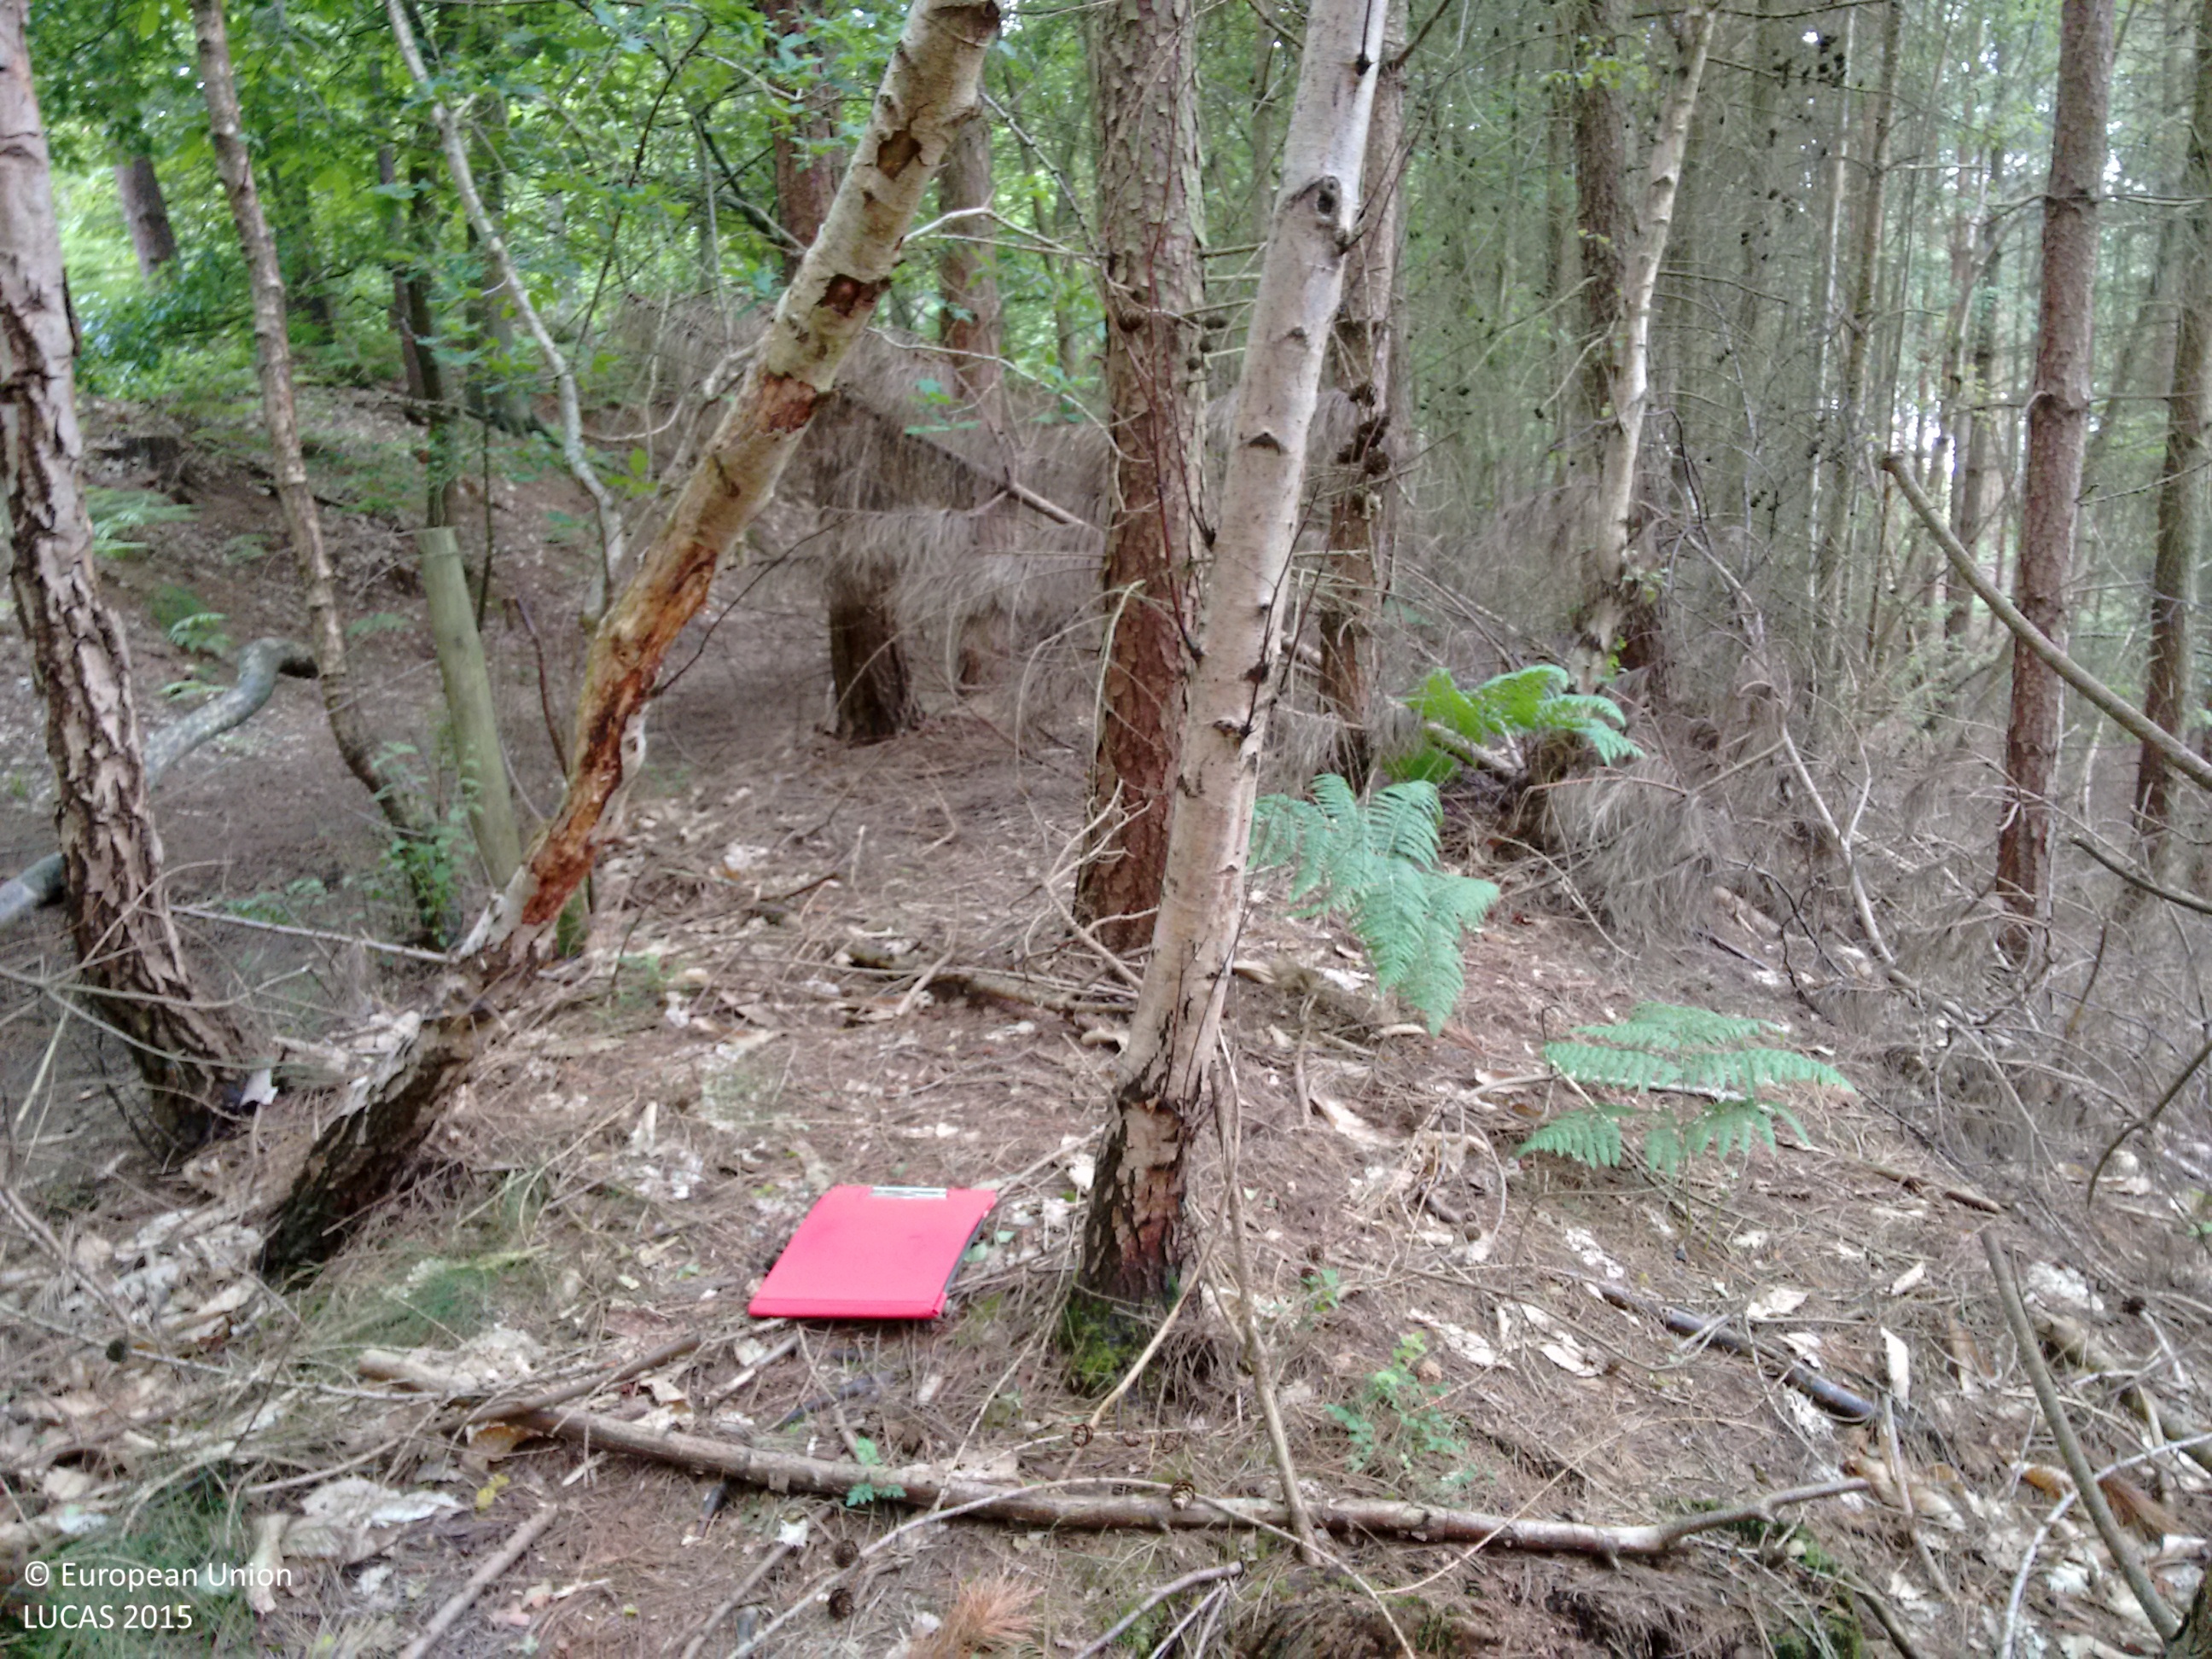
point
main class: Woodland
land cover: Pine dominated coniferous woodland
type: exotic forest
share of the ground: > 75 %
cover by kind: coniferous forest trees 90 %, broadleaved forest trees 10 %
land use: Forestry
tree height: > 5 m
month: June
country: GB
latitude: 52.0049
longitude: -0.6598
